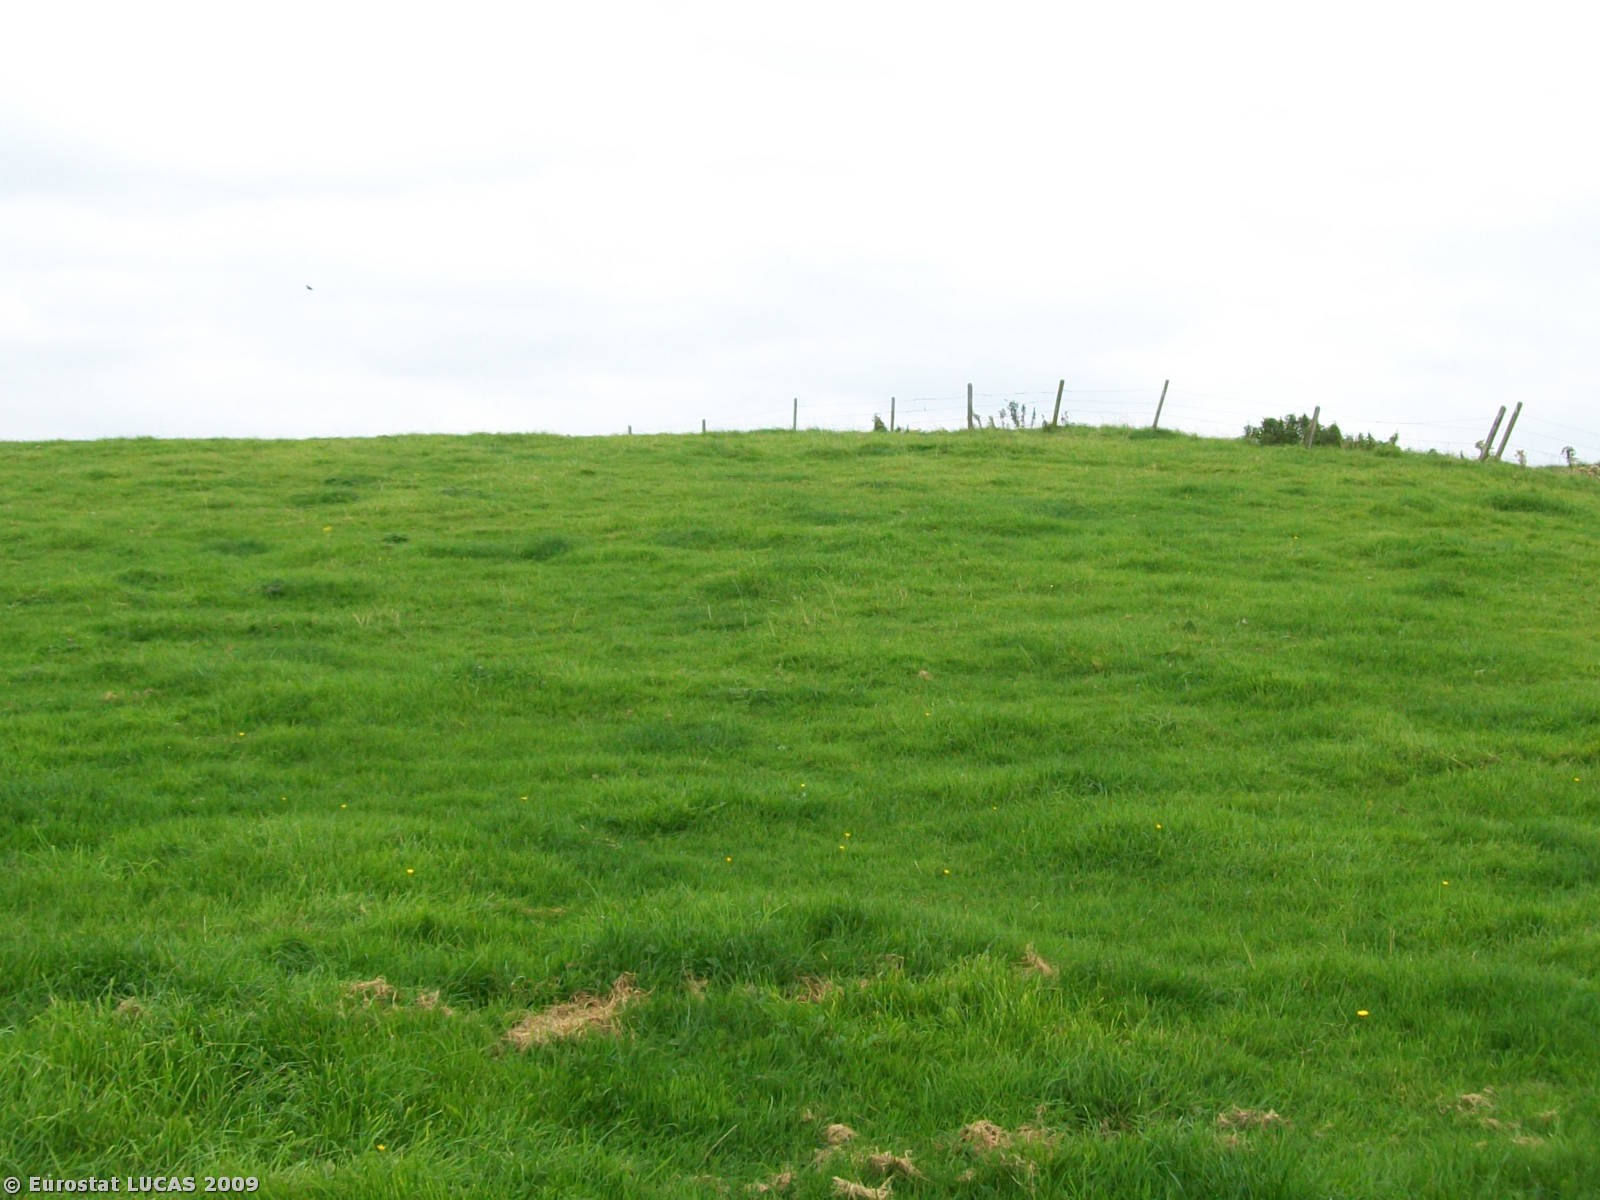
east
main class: Grassland
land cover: Grassland without tree/shrub cover
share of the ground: > 75 %
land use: Agriculture (excluding fallow land and kitchen gardens)
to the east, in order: Grassland without tree/shrub cover; Fences; Grassland without tree/shrub cover; Fences; Grassland without tree/shrub cover; Managed hedges; Fences; Grassland without tree/shrub cover
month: September
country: IE
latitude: 52.9687
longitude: -7.8137
